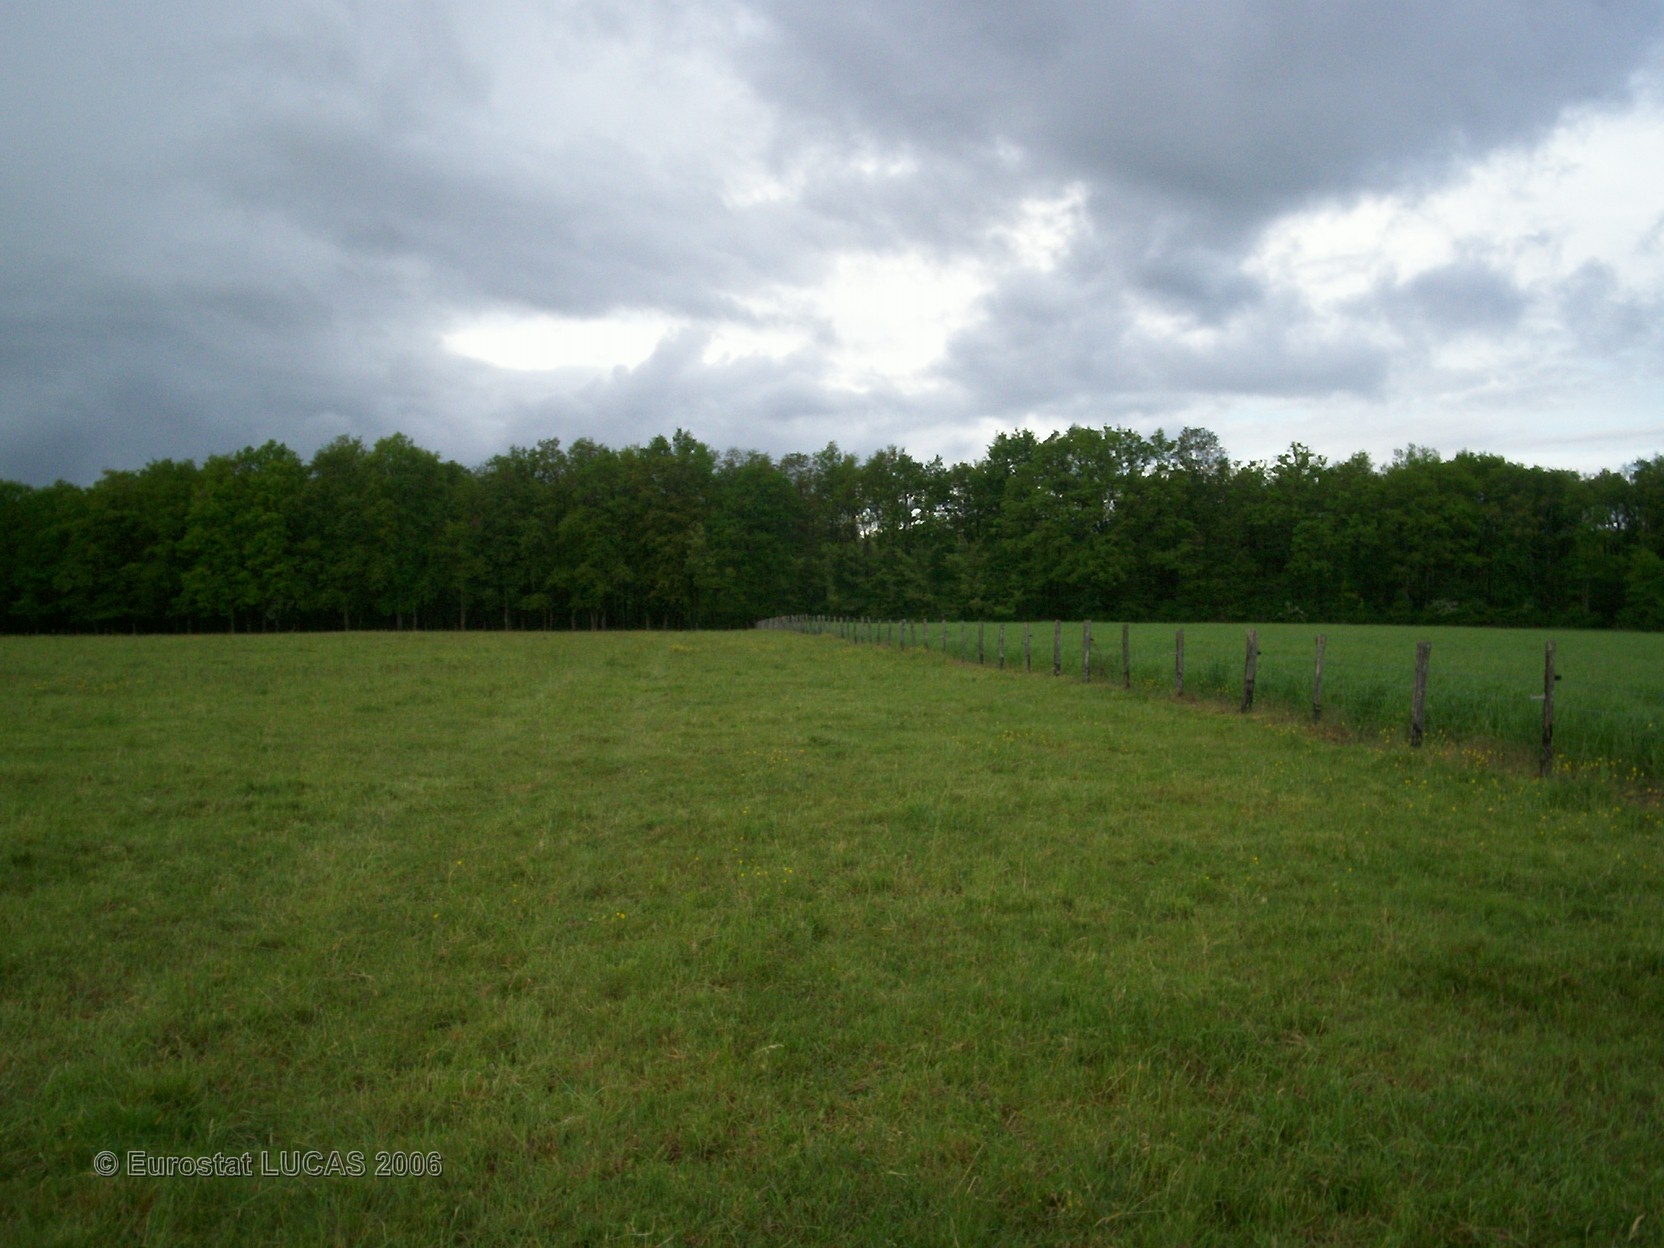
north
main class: Grassland
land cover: Grassland without tree/shrub cover
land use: Agriculture (excluding fallow land and kitchen gardens)
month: May
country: FR
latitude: 45.9460
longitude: 0.5036
